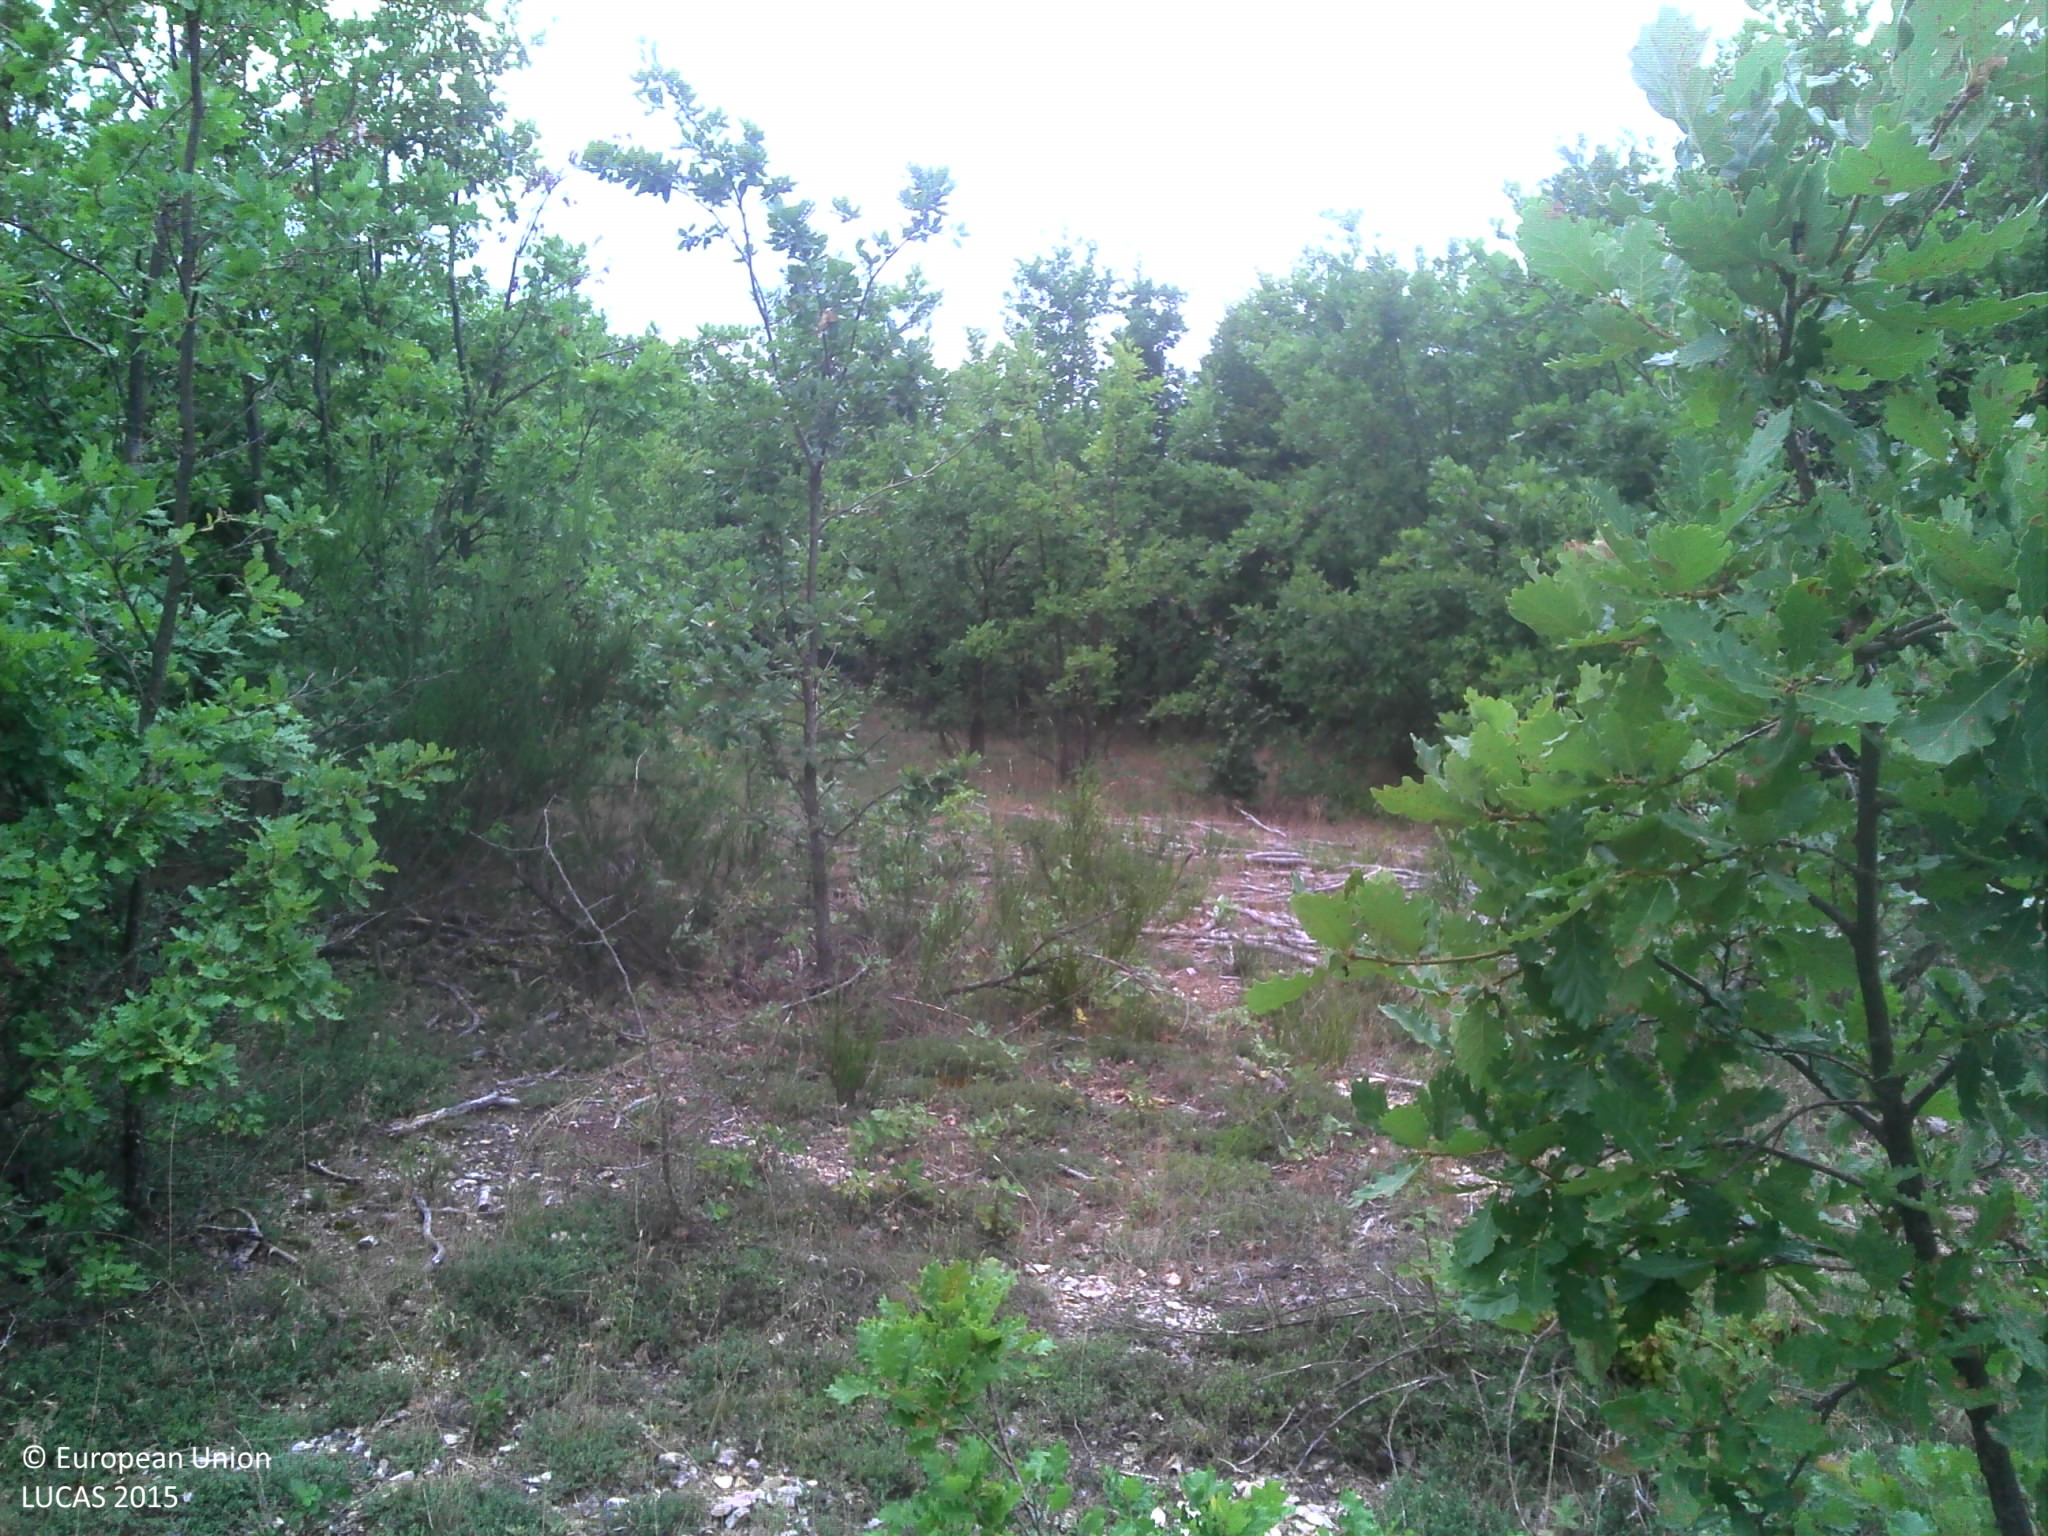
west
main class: Woodland
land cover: Broadleaved woodland
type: thermophilous deciduous forest
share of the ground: 50 - 75 %
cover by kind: broadleaved forest trees 65 %, shrubs 20 %, herbaceous plants 10 %, consolidated bare surface 5 %
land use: Forestry
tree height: > 5 m
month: July
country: FR
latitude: 44.0576
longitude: 5.5767
